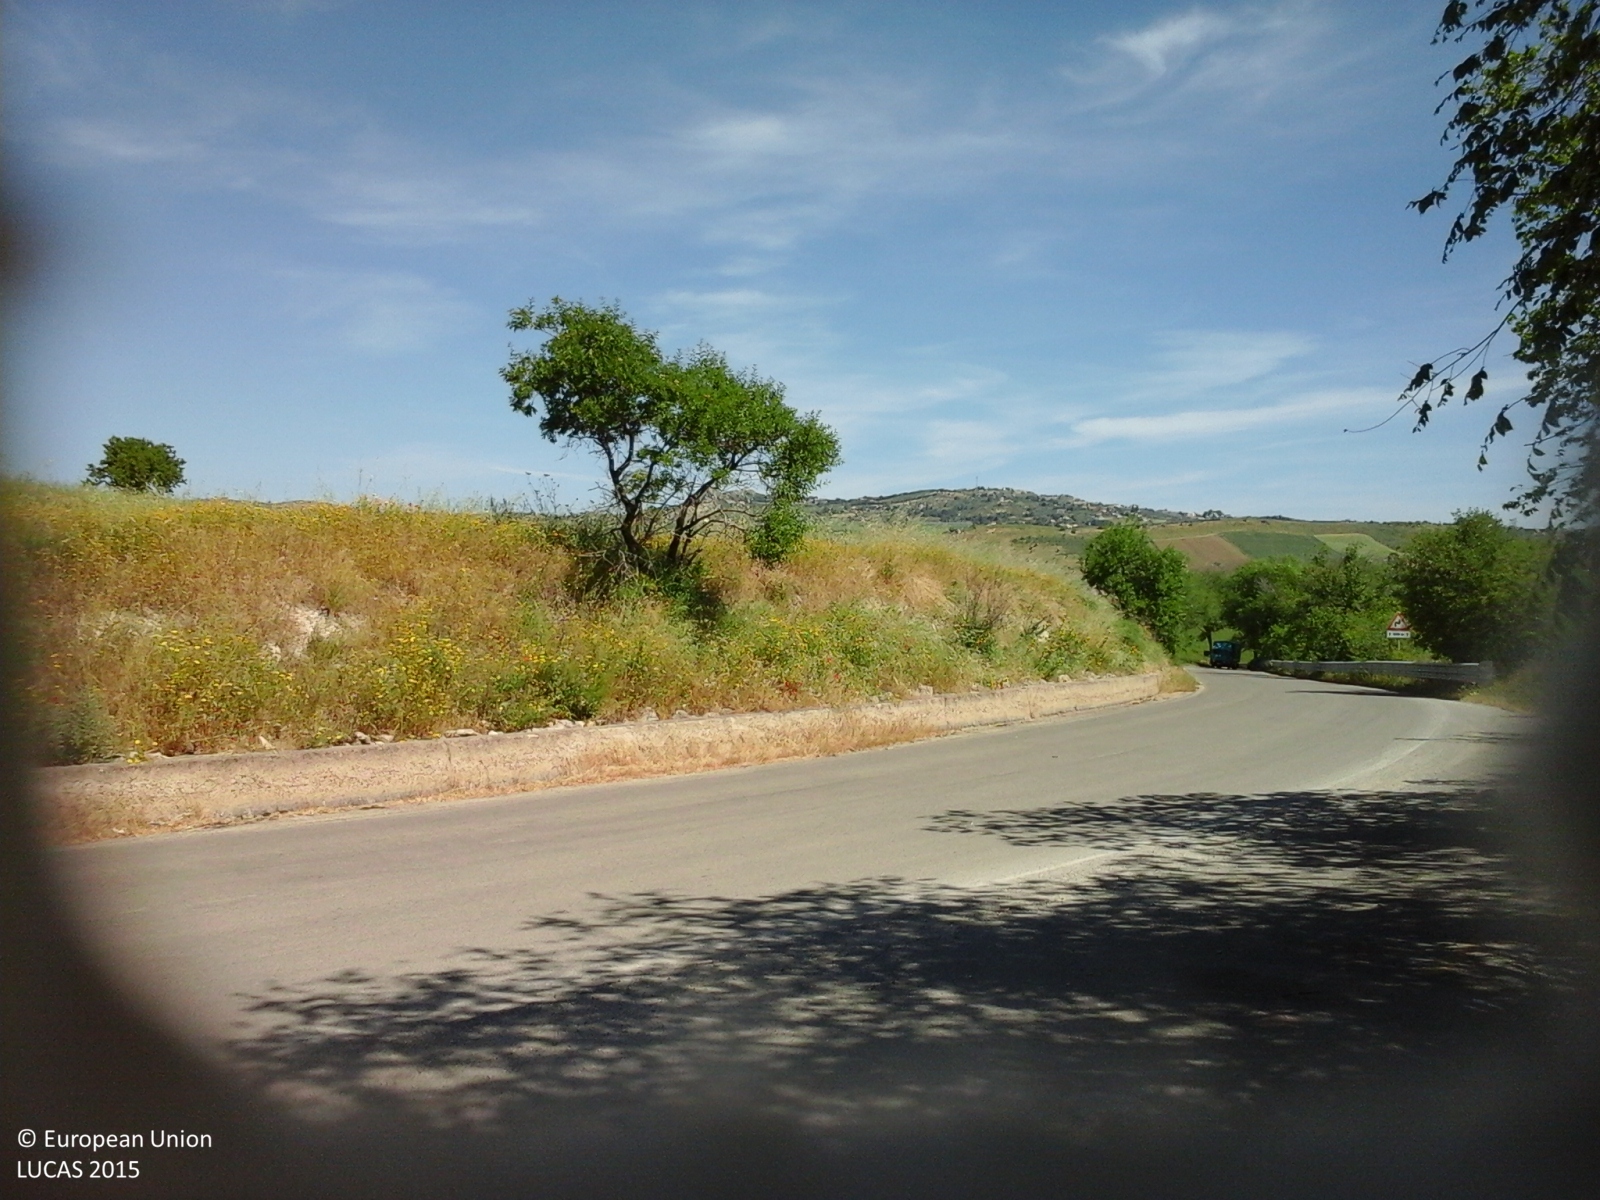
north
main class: Cropland
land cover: Vineyards
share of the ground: > 75 %
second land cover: Other bare soil
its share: > 75 %
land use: Agriculture (excluding fallow land and kitchen gardens)
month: May
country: IT
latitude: 37.4279
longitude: 13.9816
